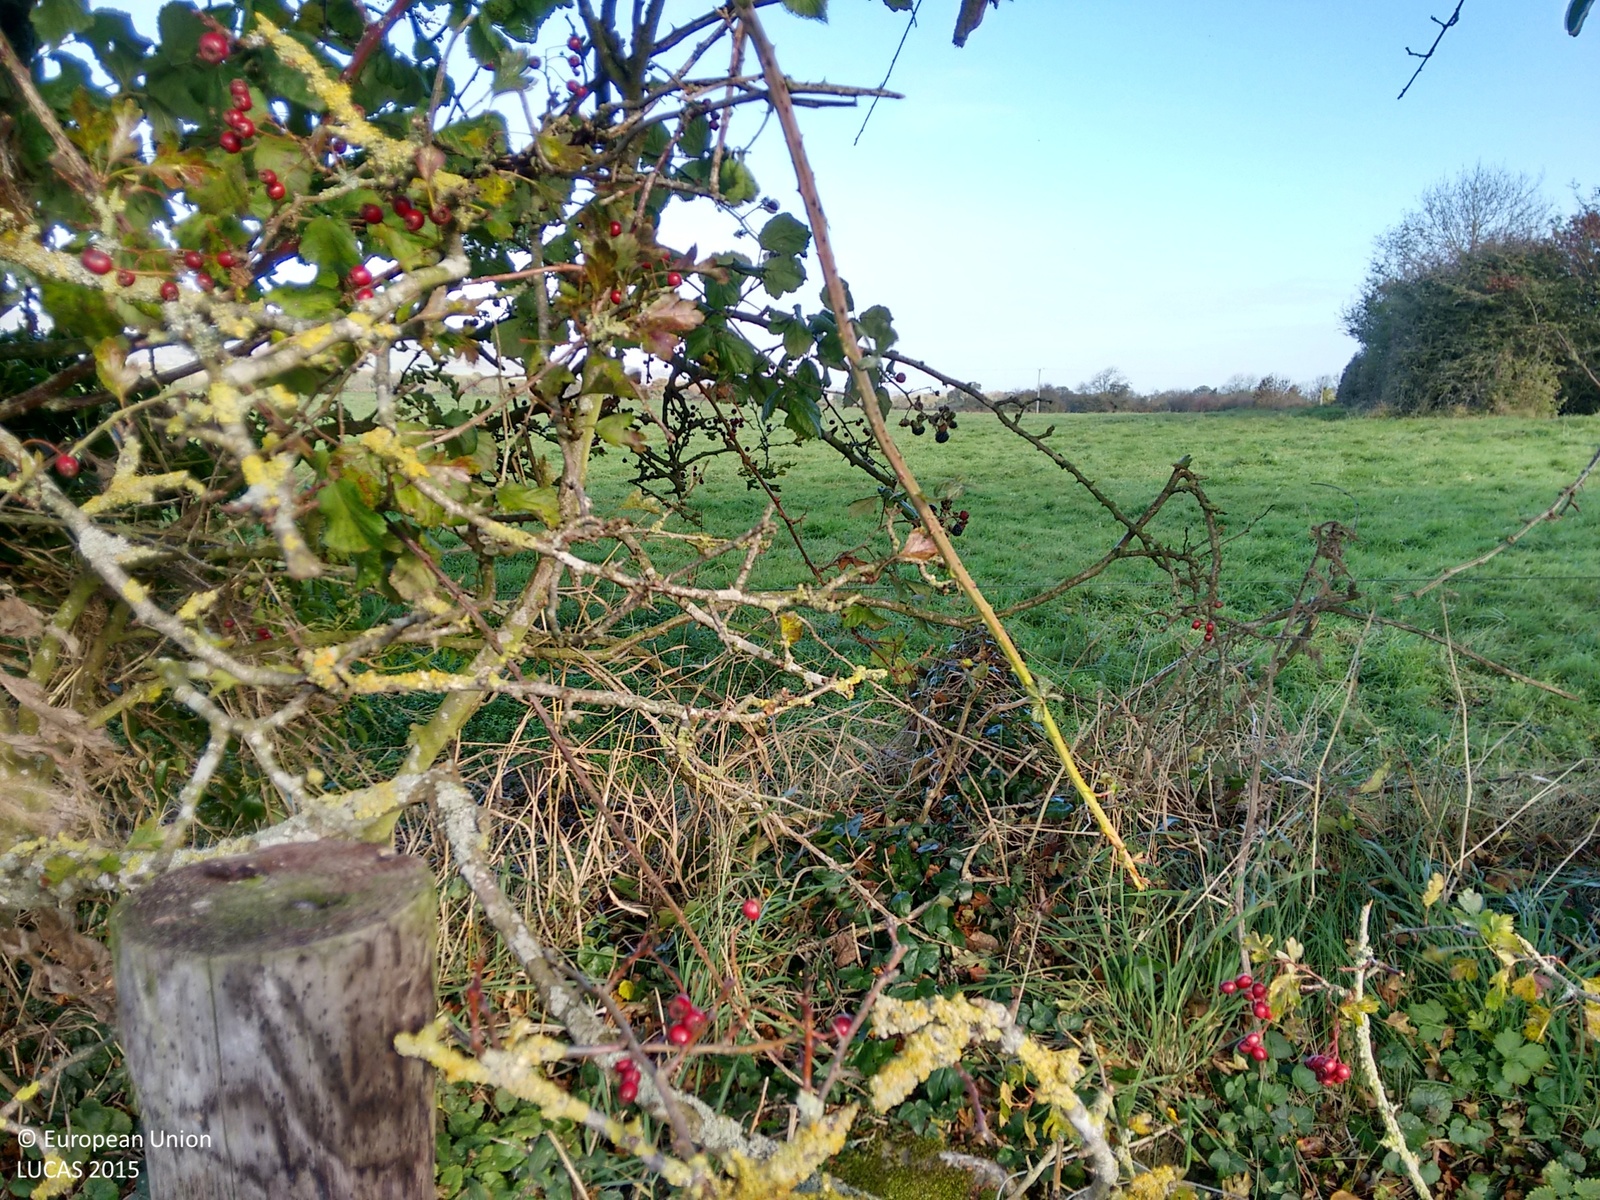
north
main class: Grassland
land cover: Grassland without tree/shrub cover
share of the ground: > 75 %
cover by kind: herbaceous plants 100 %
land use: Agriculture (excluding fallow land and kitchen gardens)
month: October
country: IE
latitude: 52.7951
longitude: -7.8638
